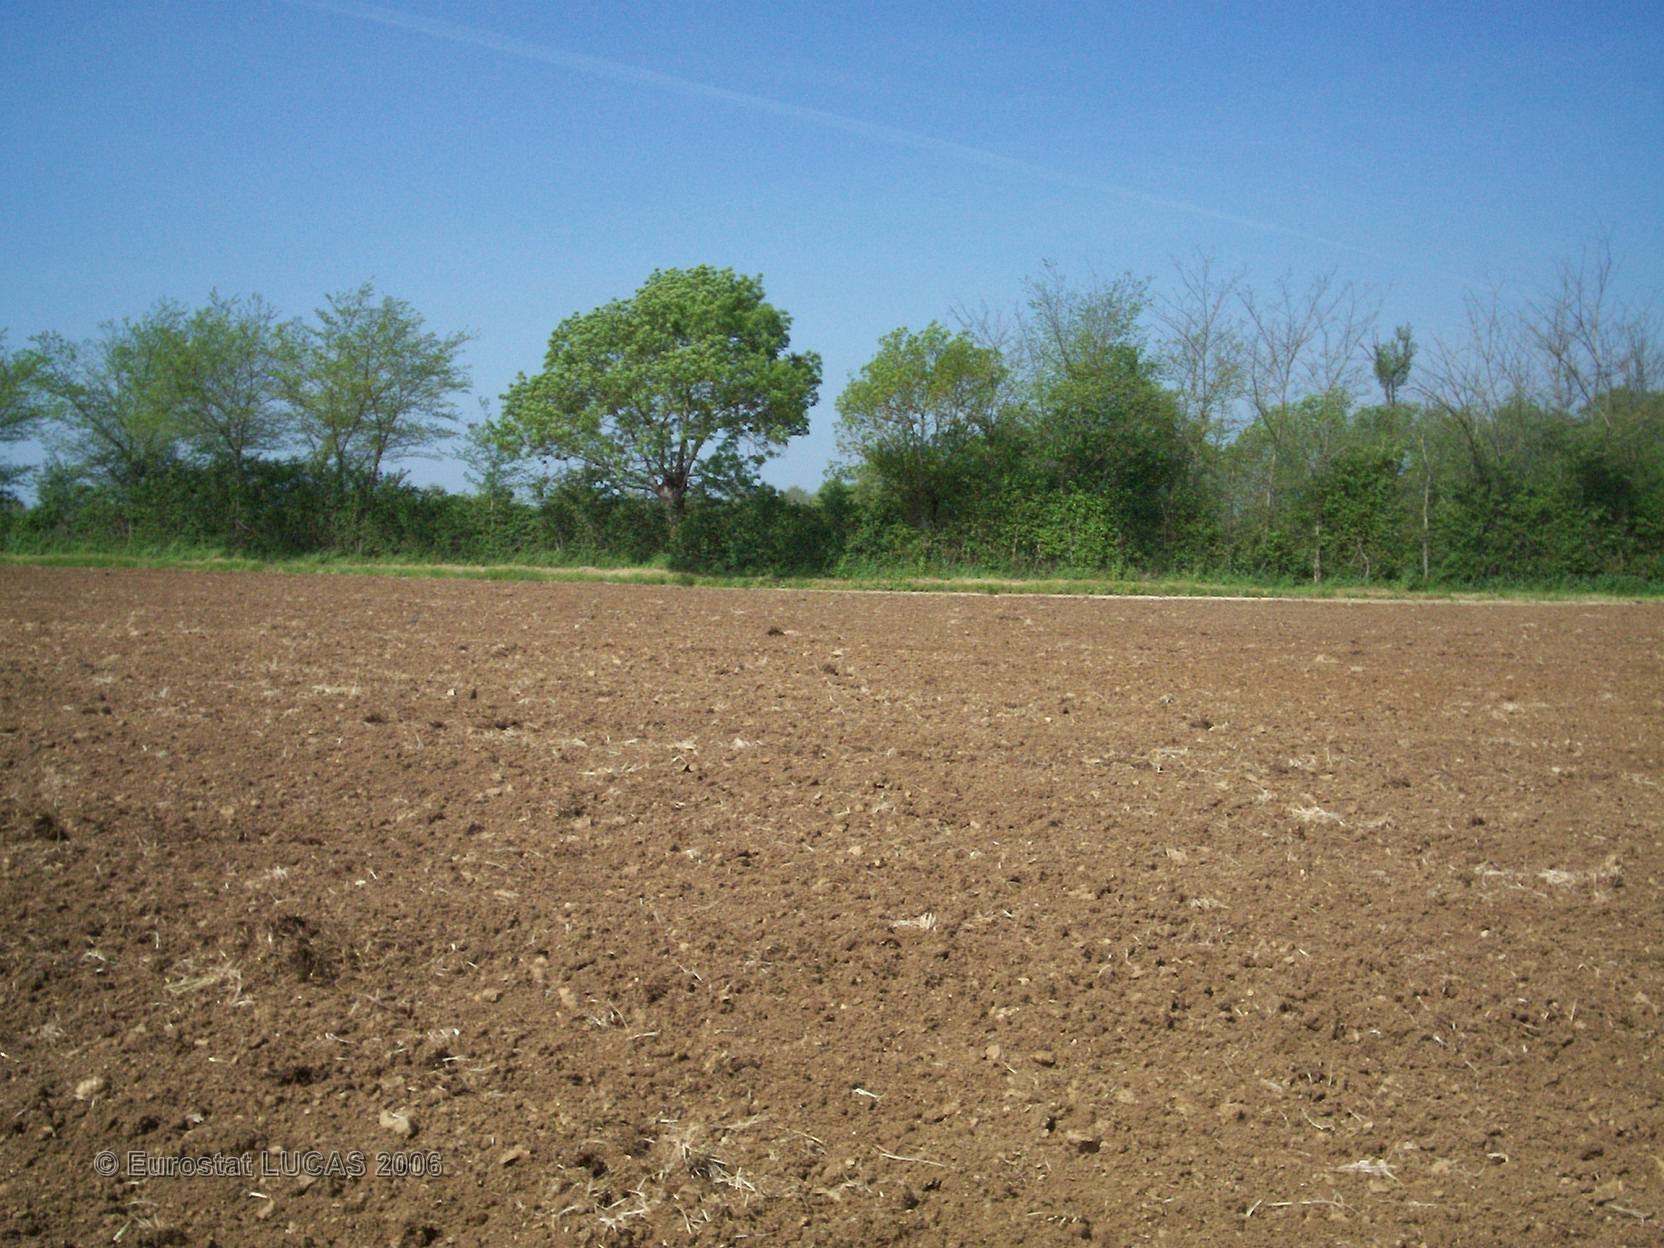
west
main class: Cropland
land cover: Sunflower
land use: Agriculture (excluding fallow land and kitchen gardens)
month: May
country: FR
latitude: 46.1669
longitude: -0.2411
